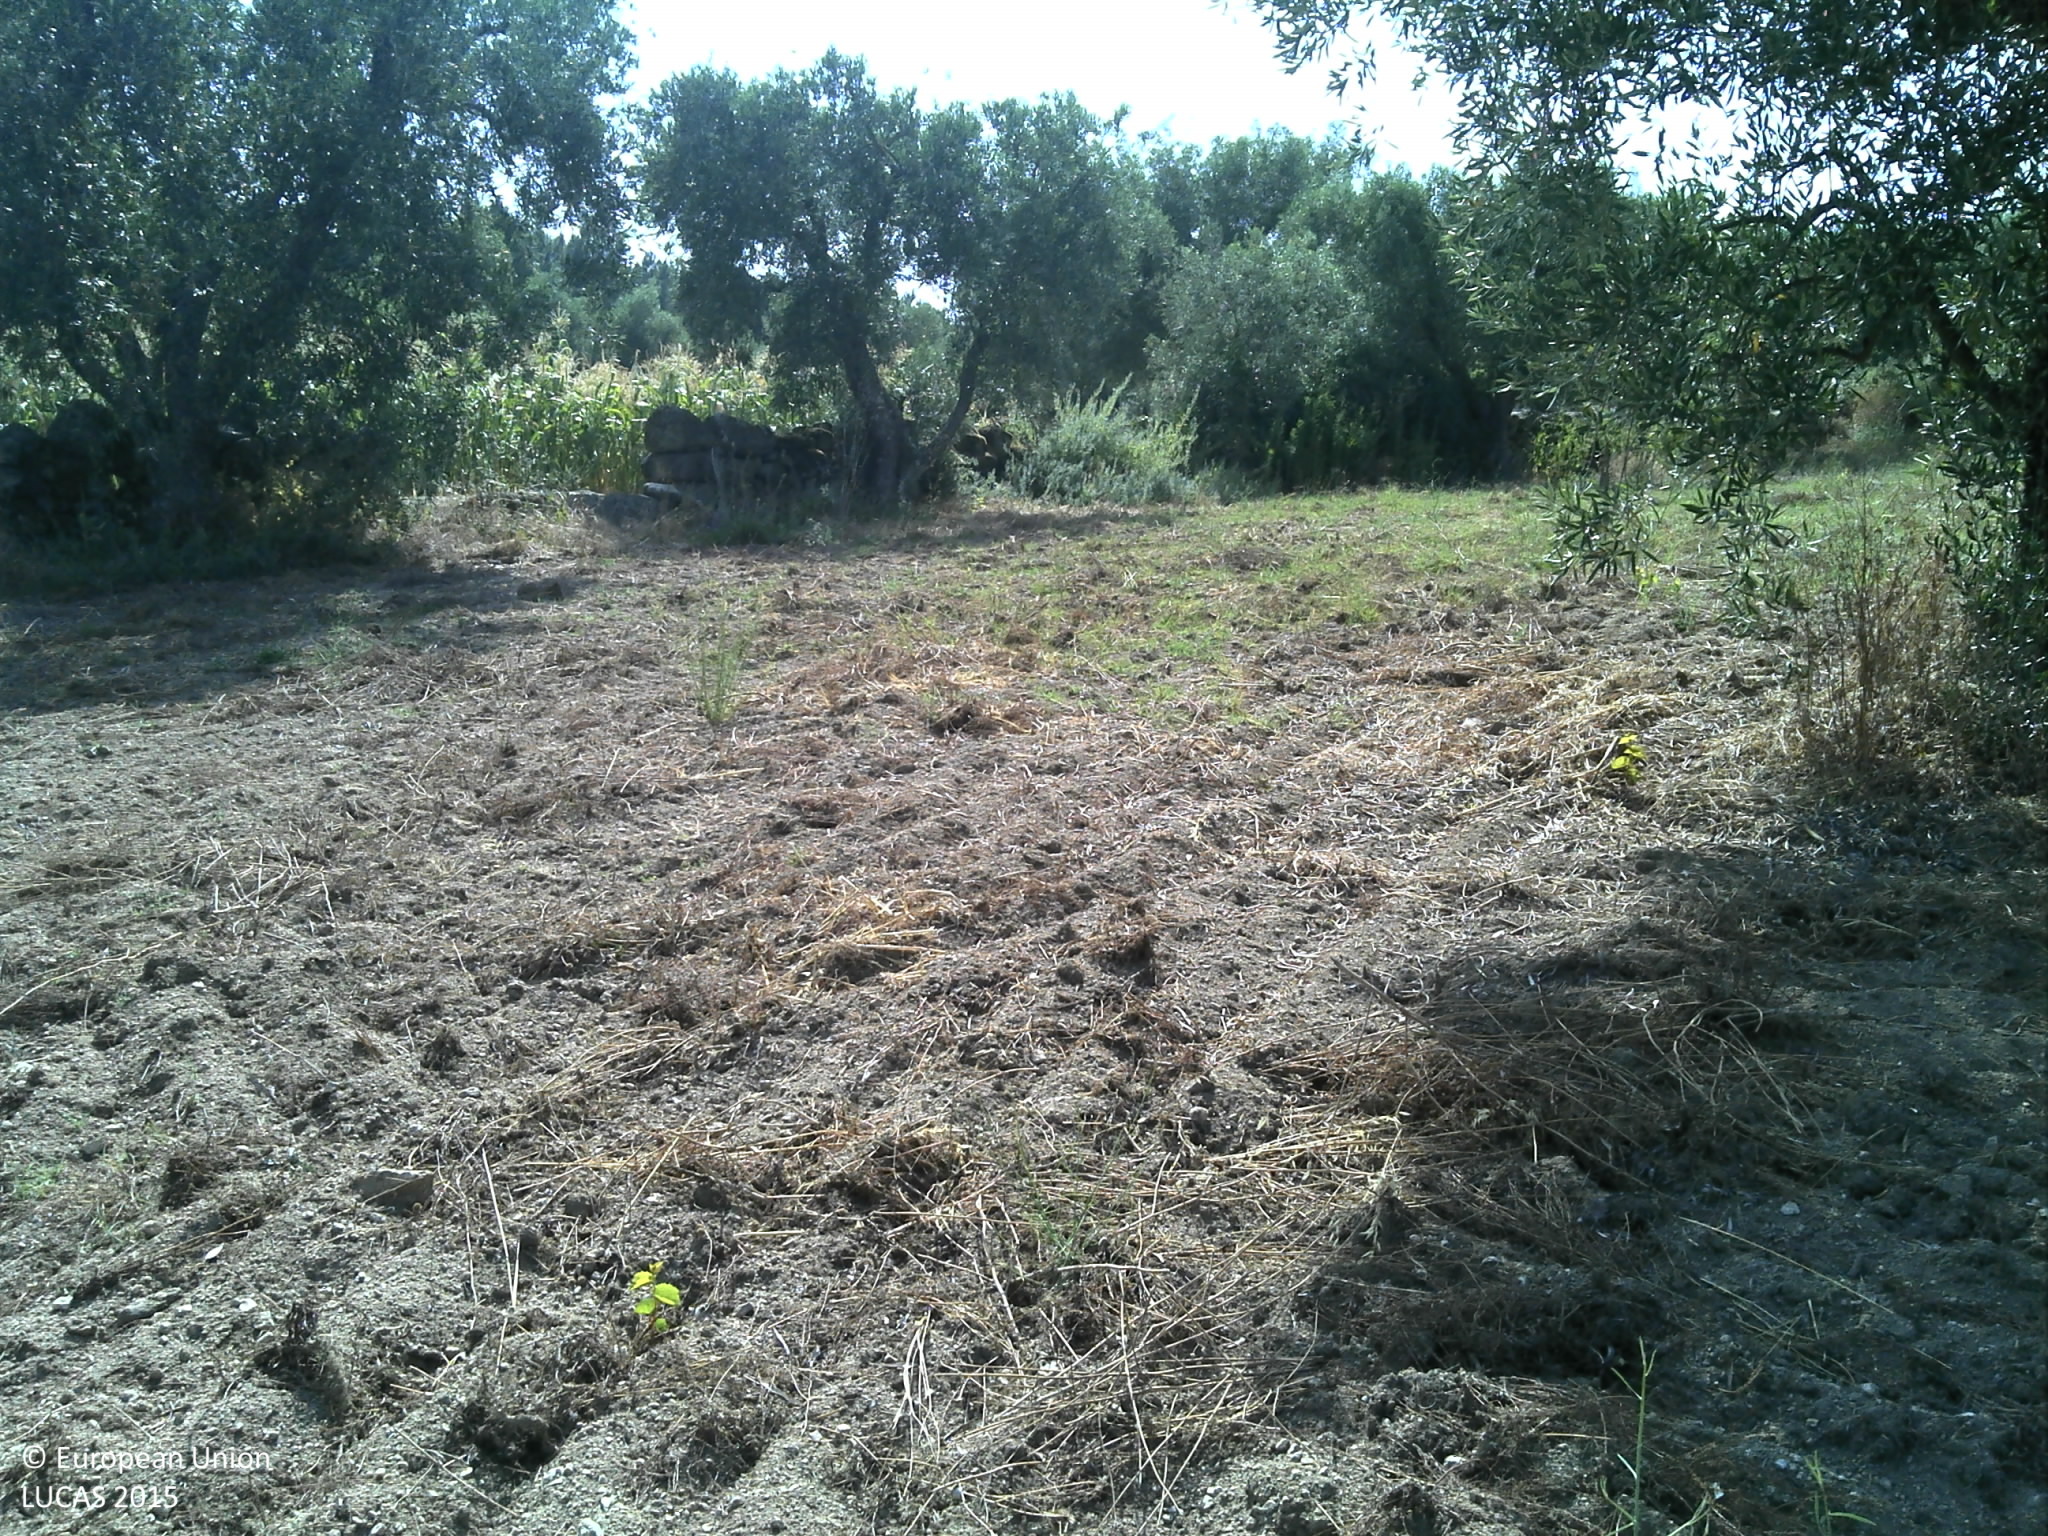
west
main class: Cropland
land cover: Olive groves
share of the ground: < 10 %
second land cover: Spontaneously vegetated surfaces
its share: 25 - 50 %
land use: Agriculture (excluding fallow land and kitchen gardens)
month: July
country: PT
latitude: 40.9249
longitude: -7.5397
